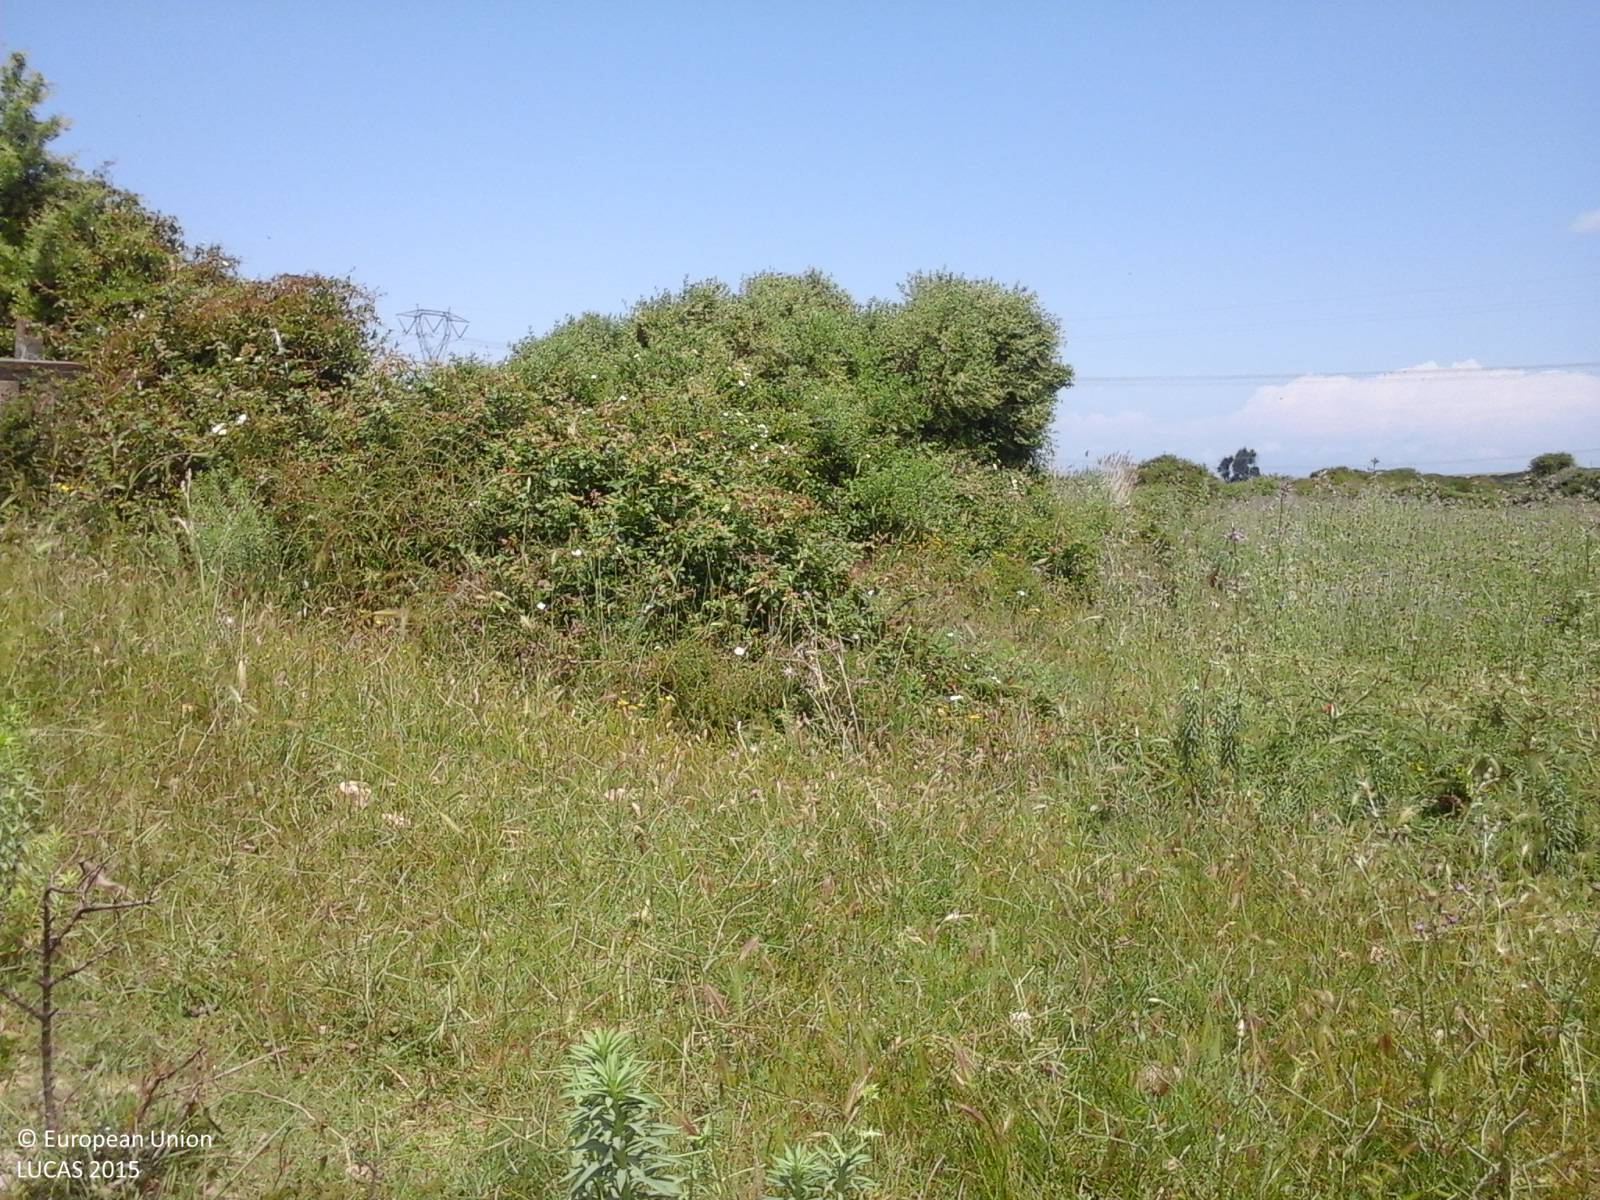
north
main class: Grassland
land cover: Spontaneously vegetated surfaces
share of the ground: > 75 %
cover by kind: herbaceous plants 50 %, shrubs 5 %, unconsolidated bare surface 5 %
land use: Agriculture (excluding fallow land and kitchen gardens)
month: May
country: IT
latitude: 40.7428
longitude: 8.3853
